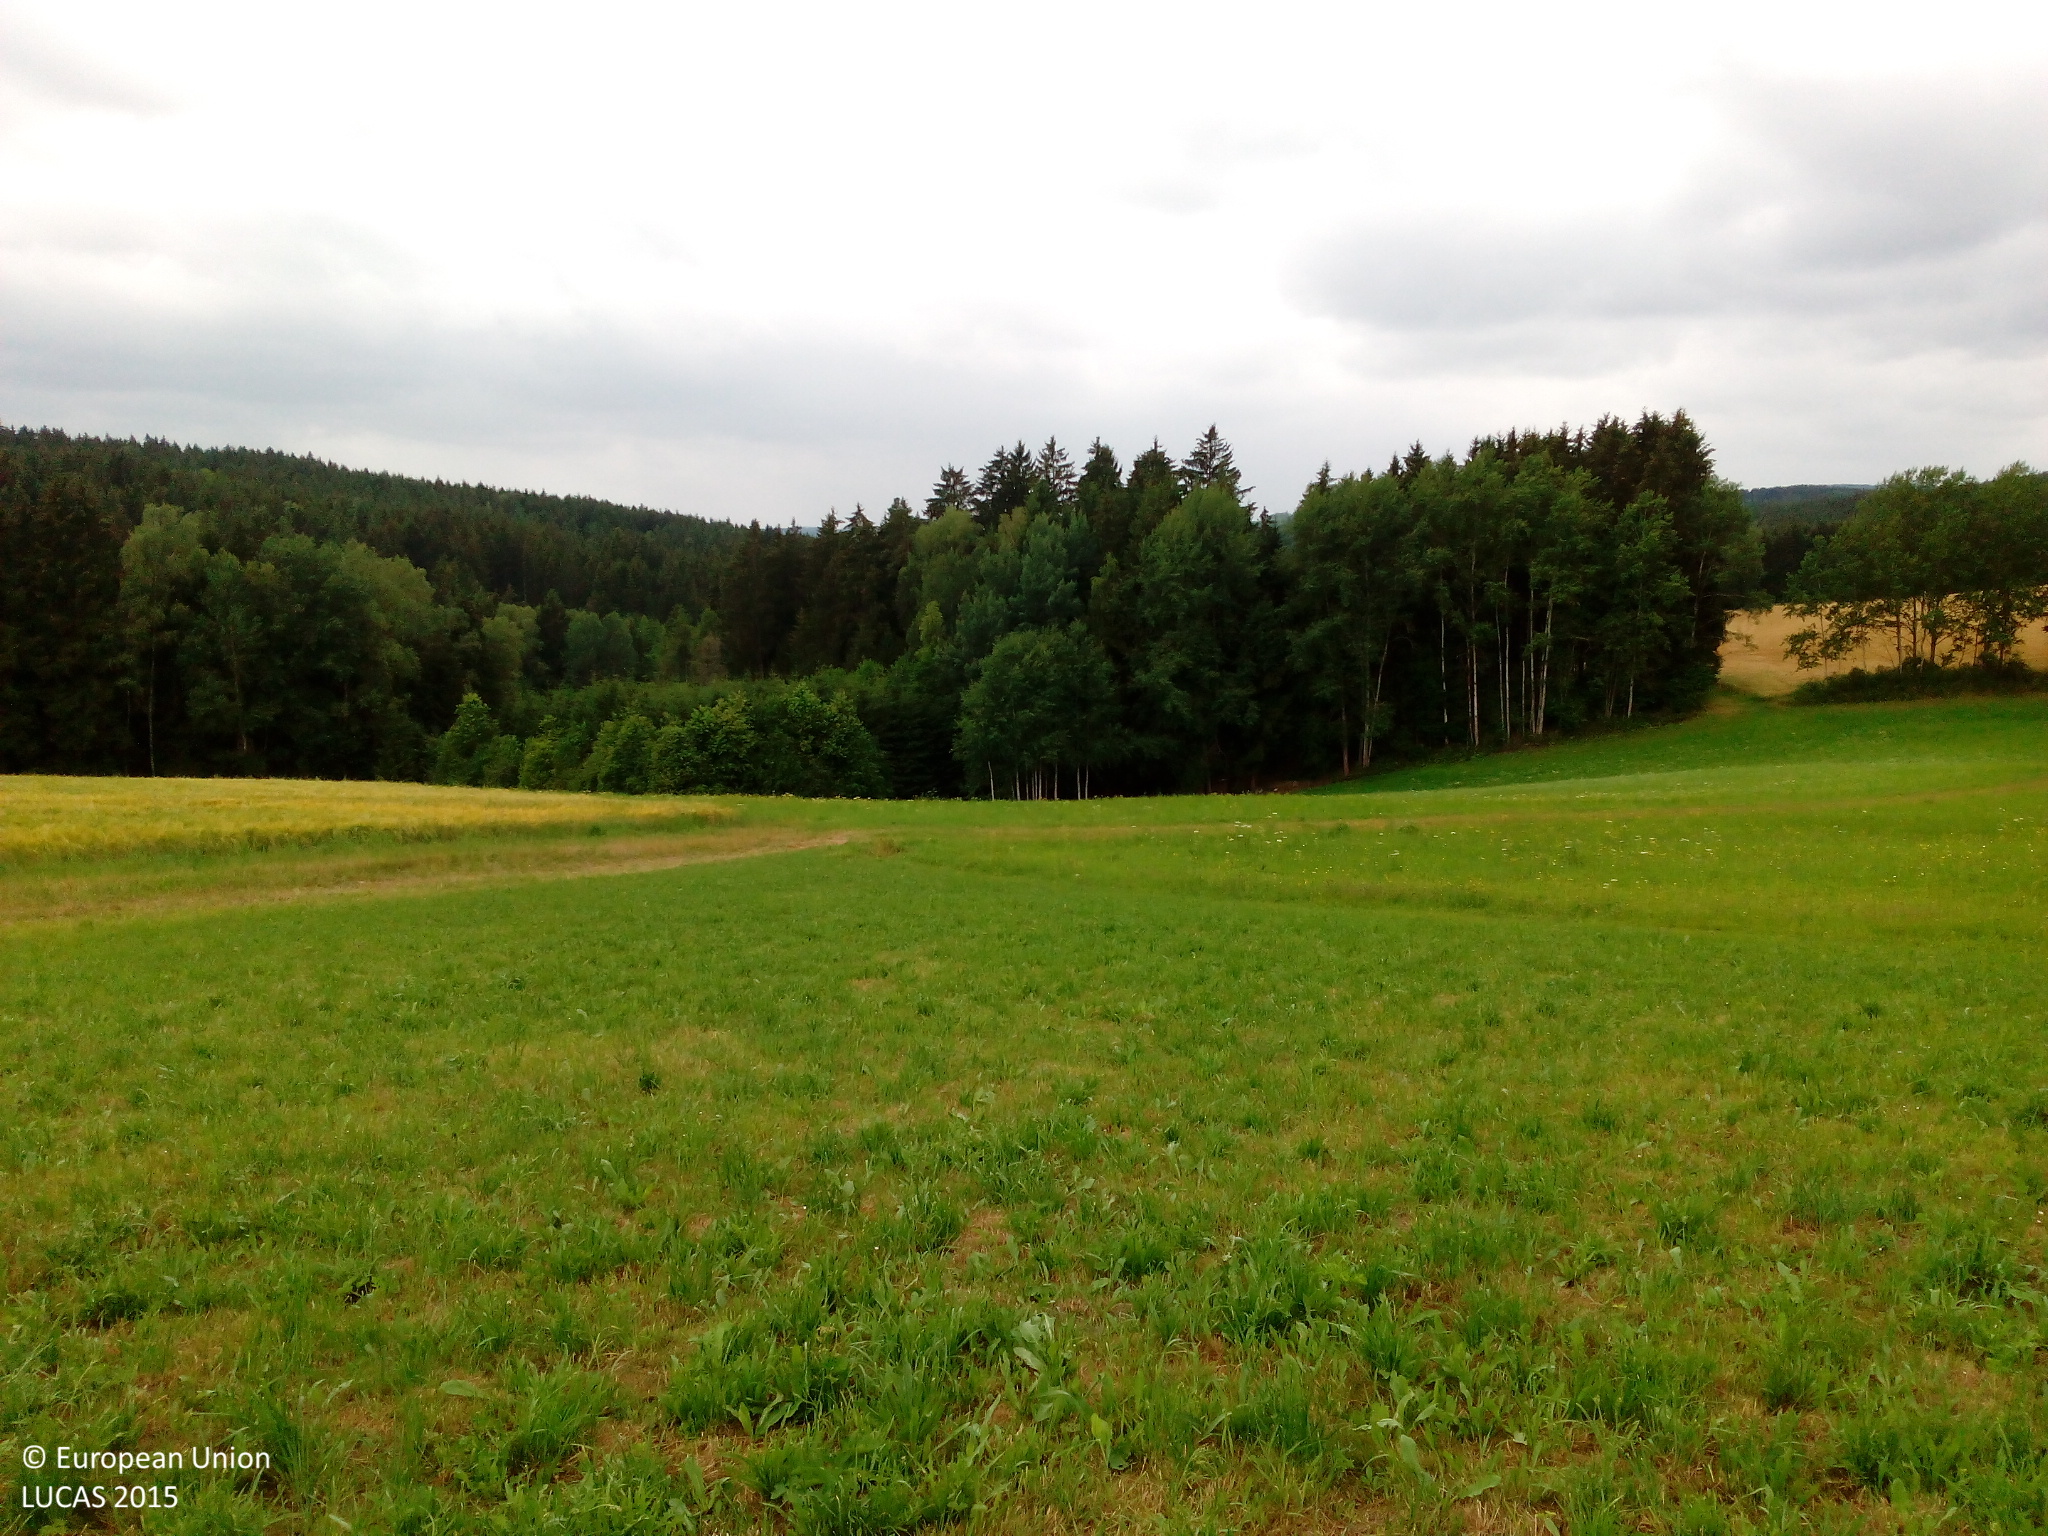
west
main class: Grassland
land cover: Grassland without tree/shrub cover
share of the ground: > 75 %
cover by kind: herbaceous plants 75 %, unconsolidated bare surface 5 %
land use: Agriculture (excluding fallow land and kitchen gardens)
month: July
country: DE
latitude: 49.4924
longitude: 12.4432
